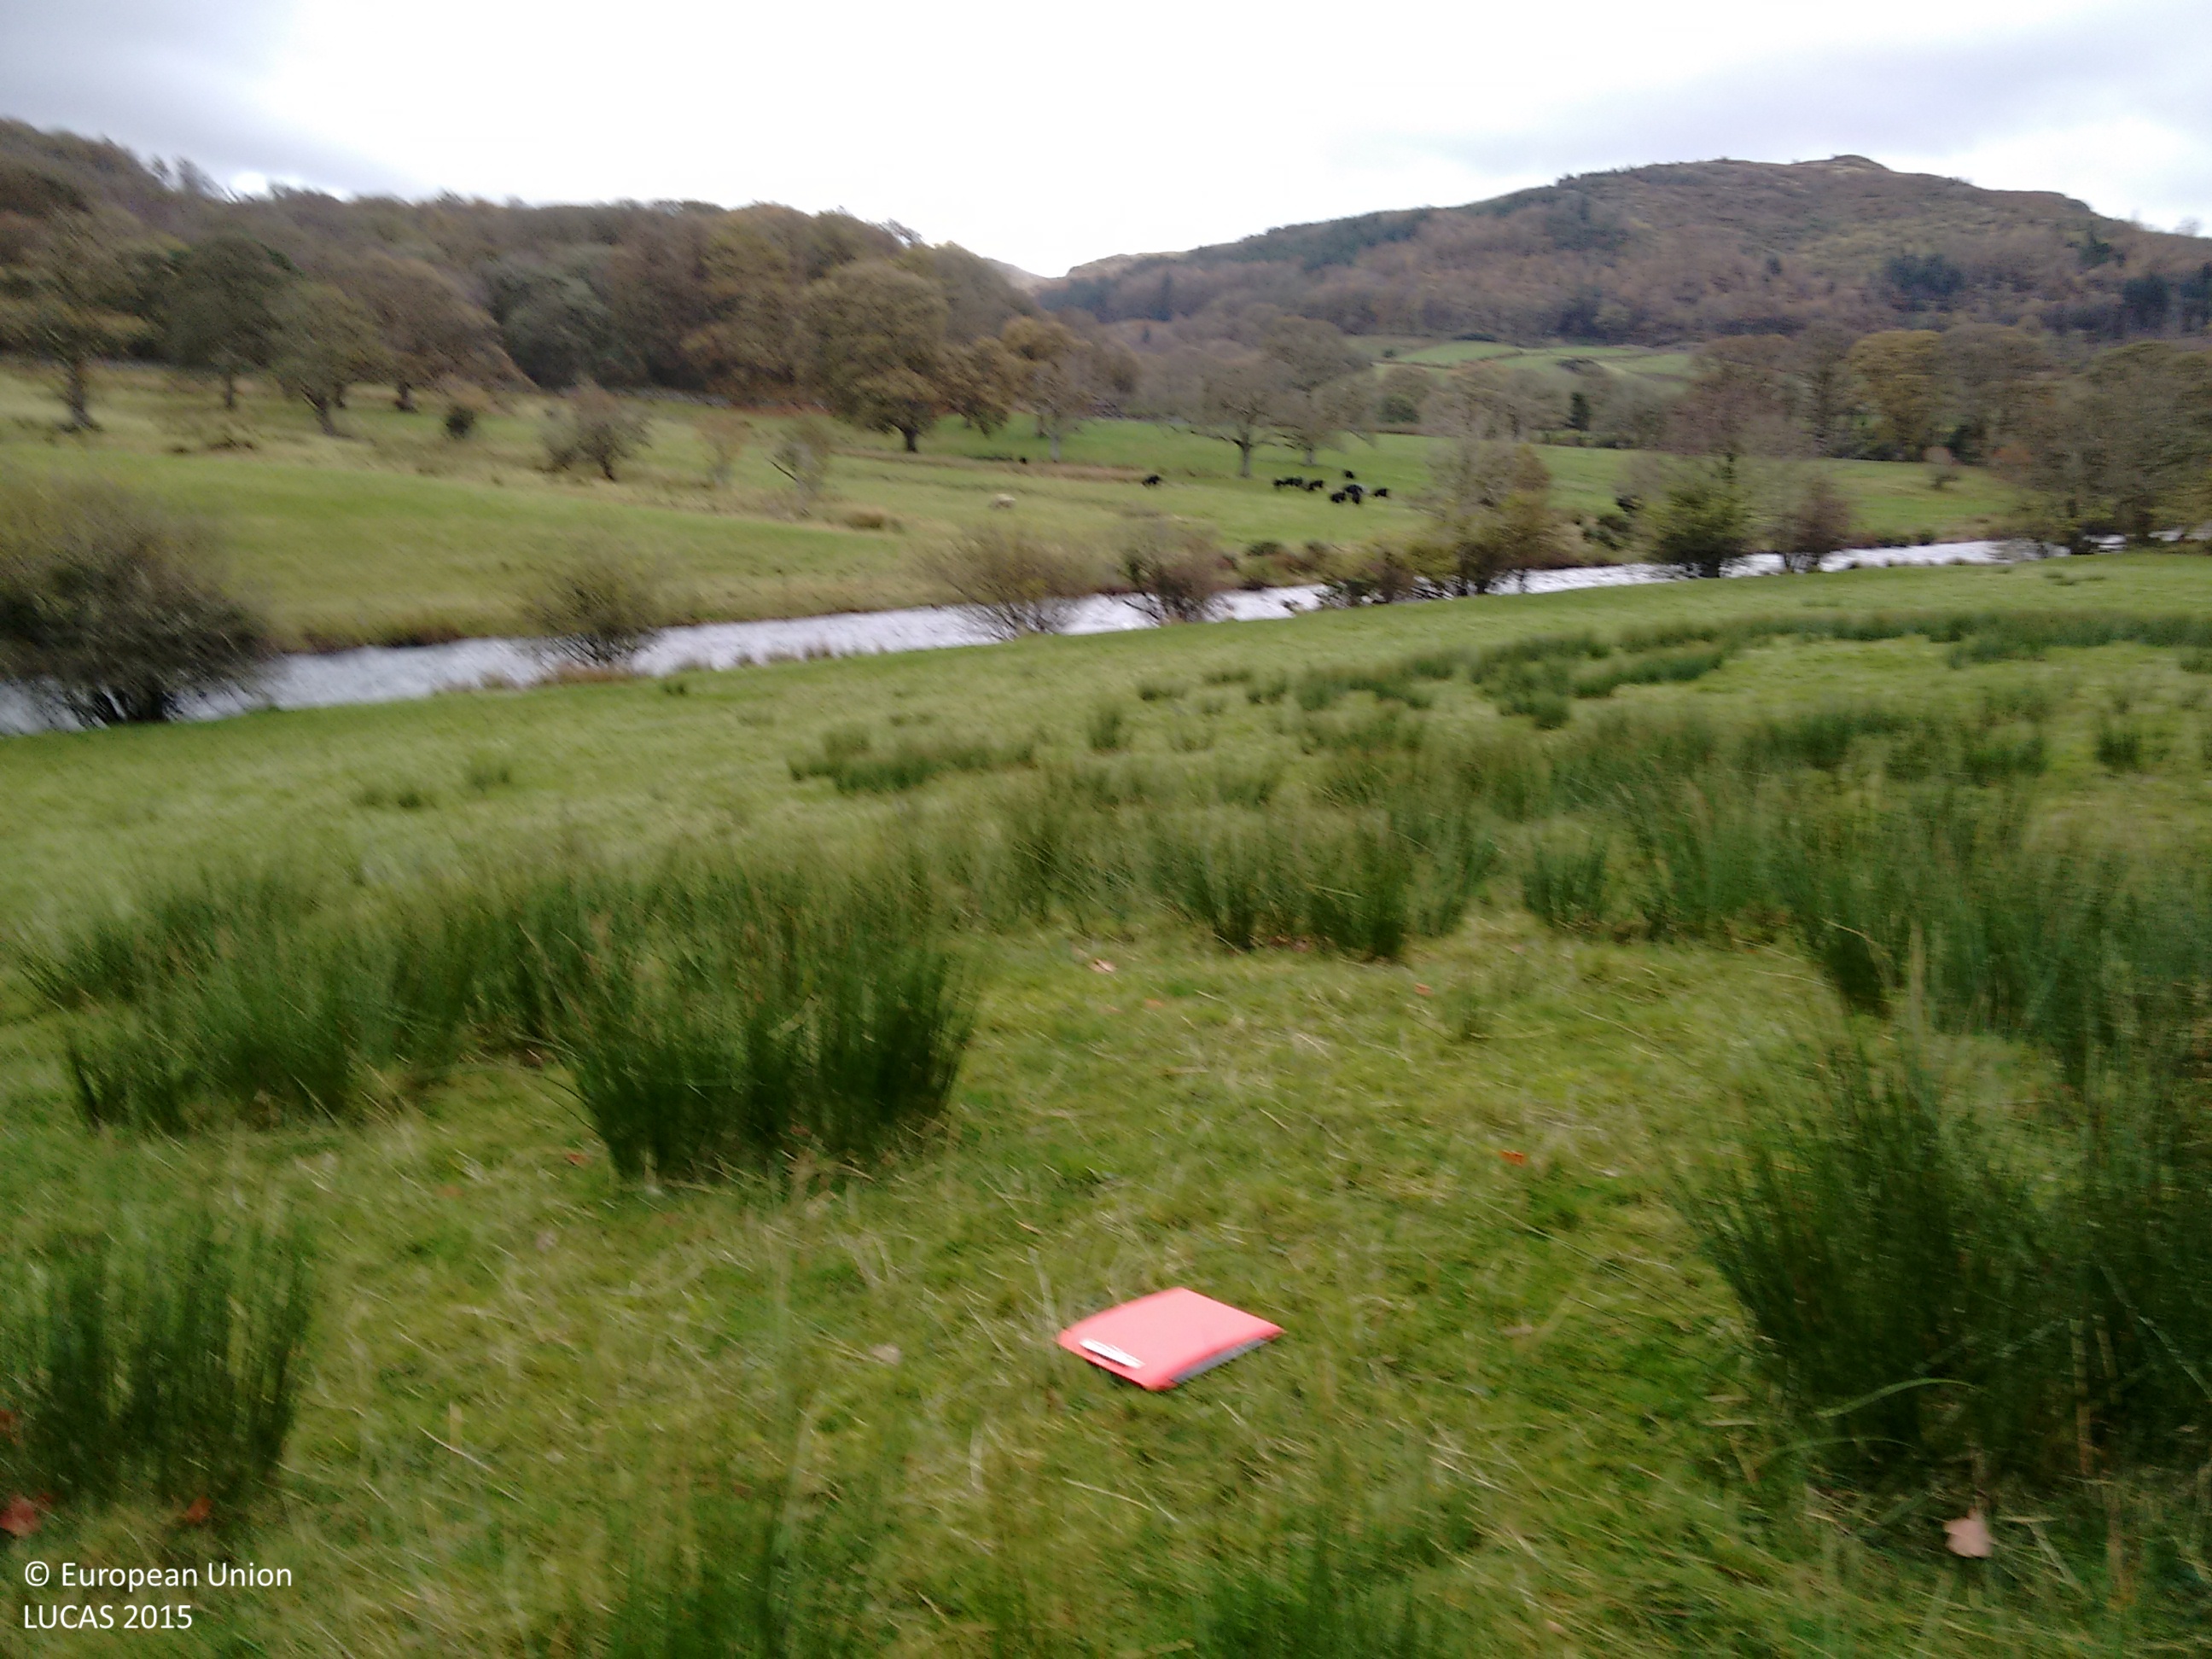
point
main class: Grassland
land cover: Grassland without tree/shrub cover
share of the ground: > 75 %
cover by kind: herbaceous plants 100 %
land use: Agriculture (excluding fallow land and kitchen gardens)
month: November
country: GB
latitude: 54.4066
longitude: -3.3753
